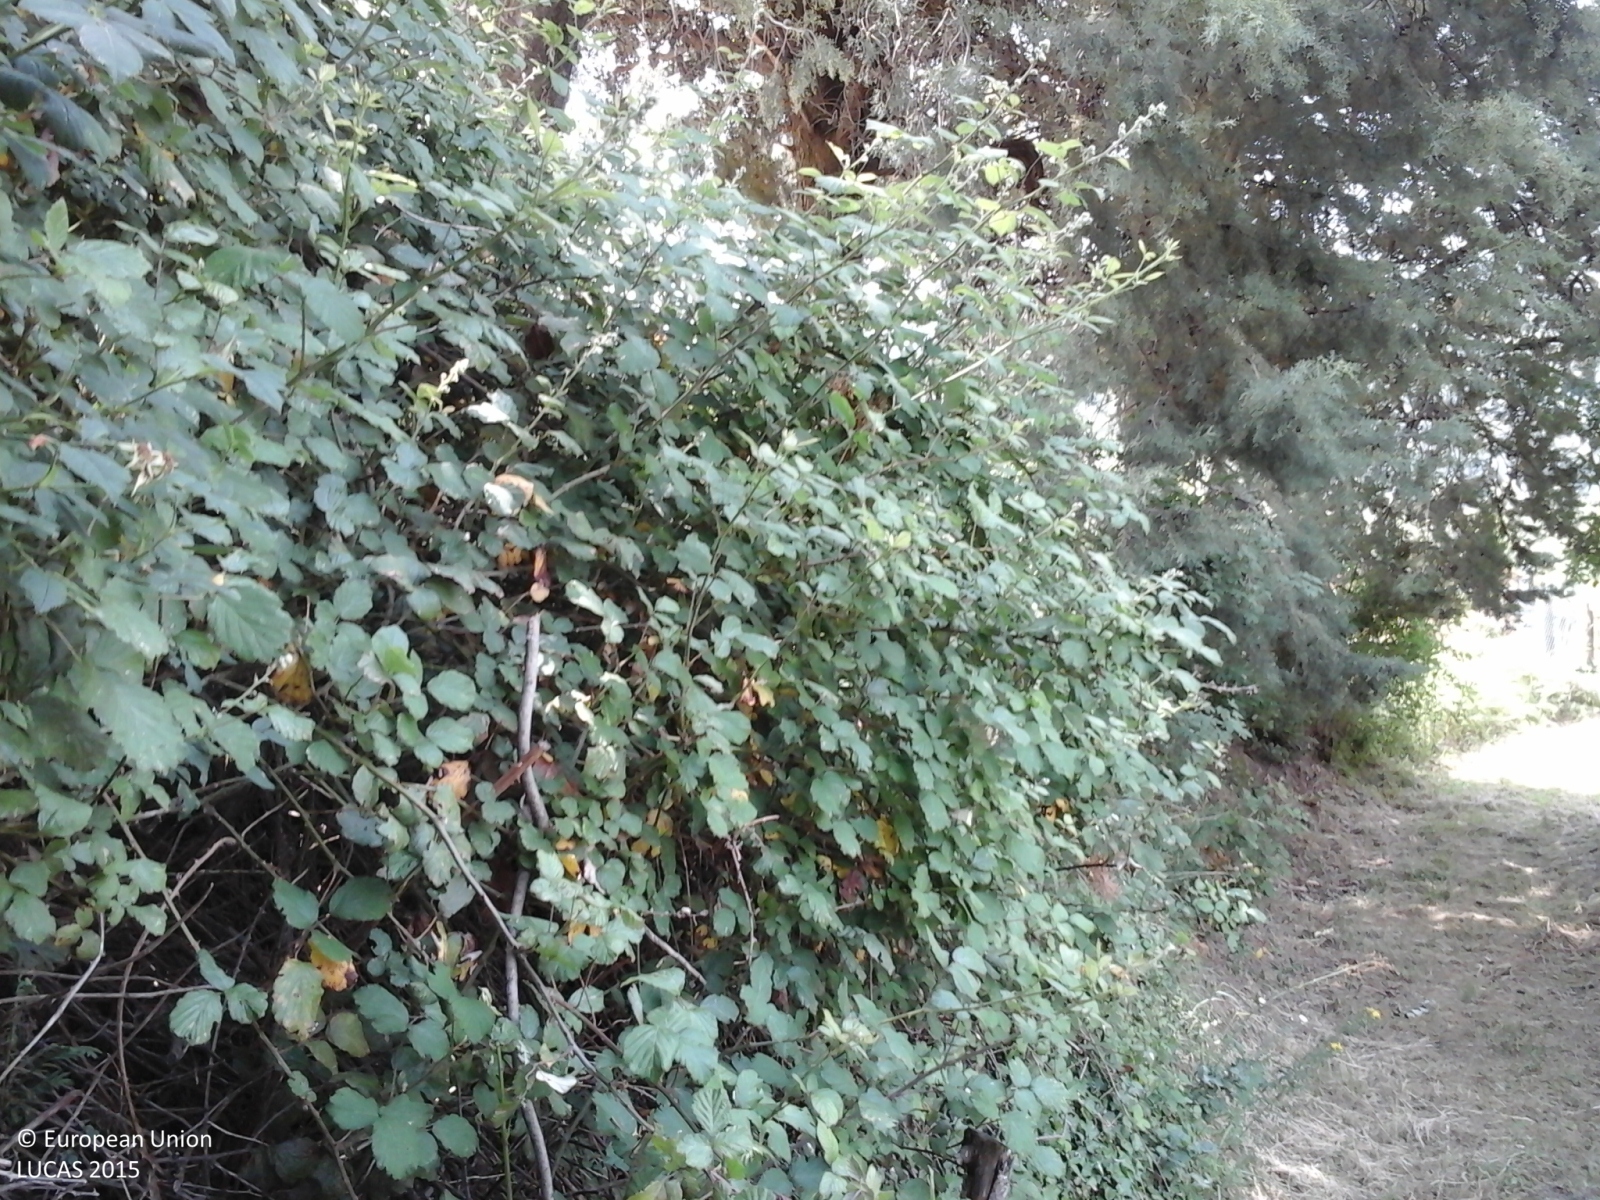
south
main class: Shrubland
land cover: Shrubland with sparse tree cover
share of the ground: > 75 %
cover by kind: shrubs 85 %, herbaceous plants 10 %, broadleaved forest trees 5 %
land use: Semi-natural and natural areas not in use
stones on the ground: < 10 %
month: June
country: IT
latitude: 43.8334
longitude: 11.5754
